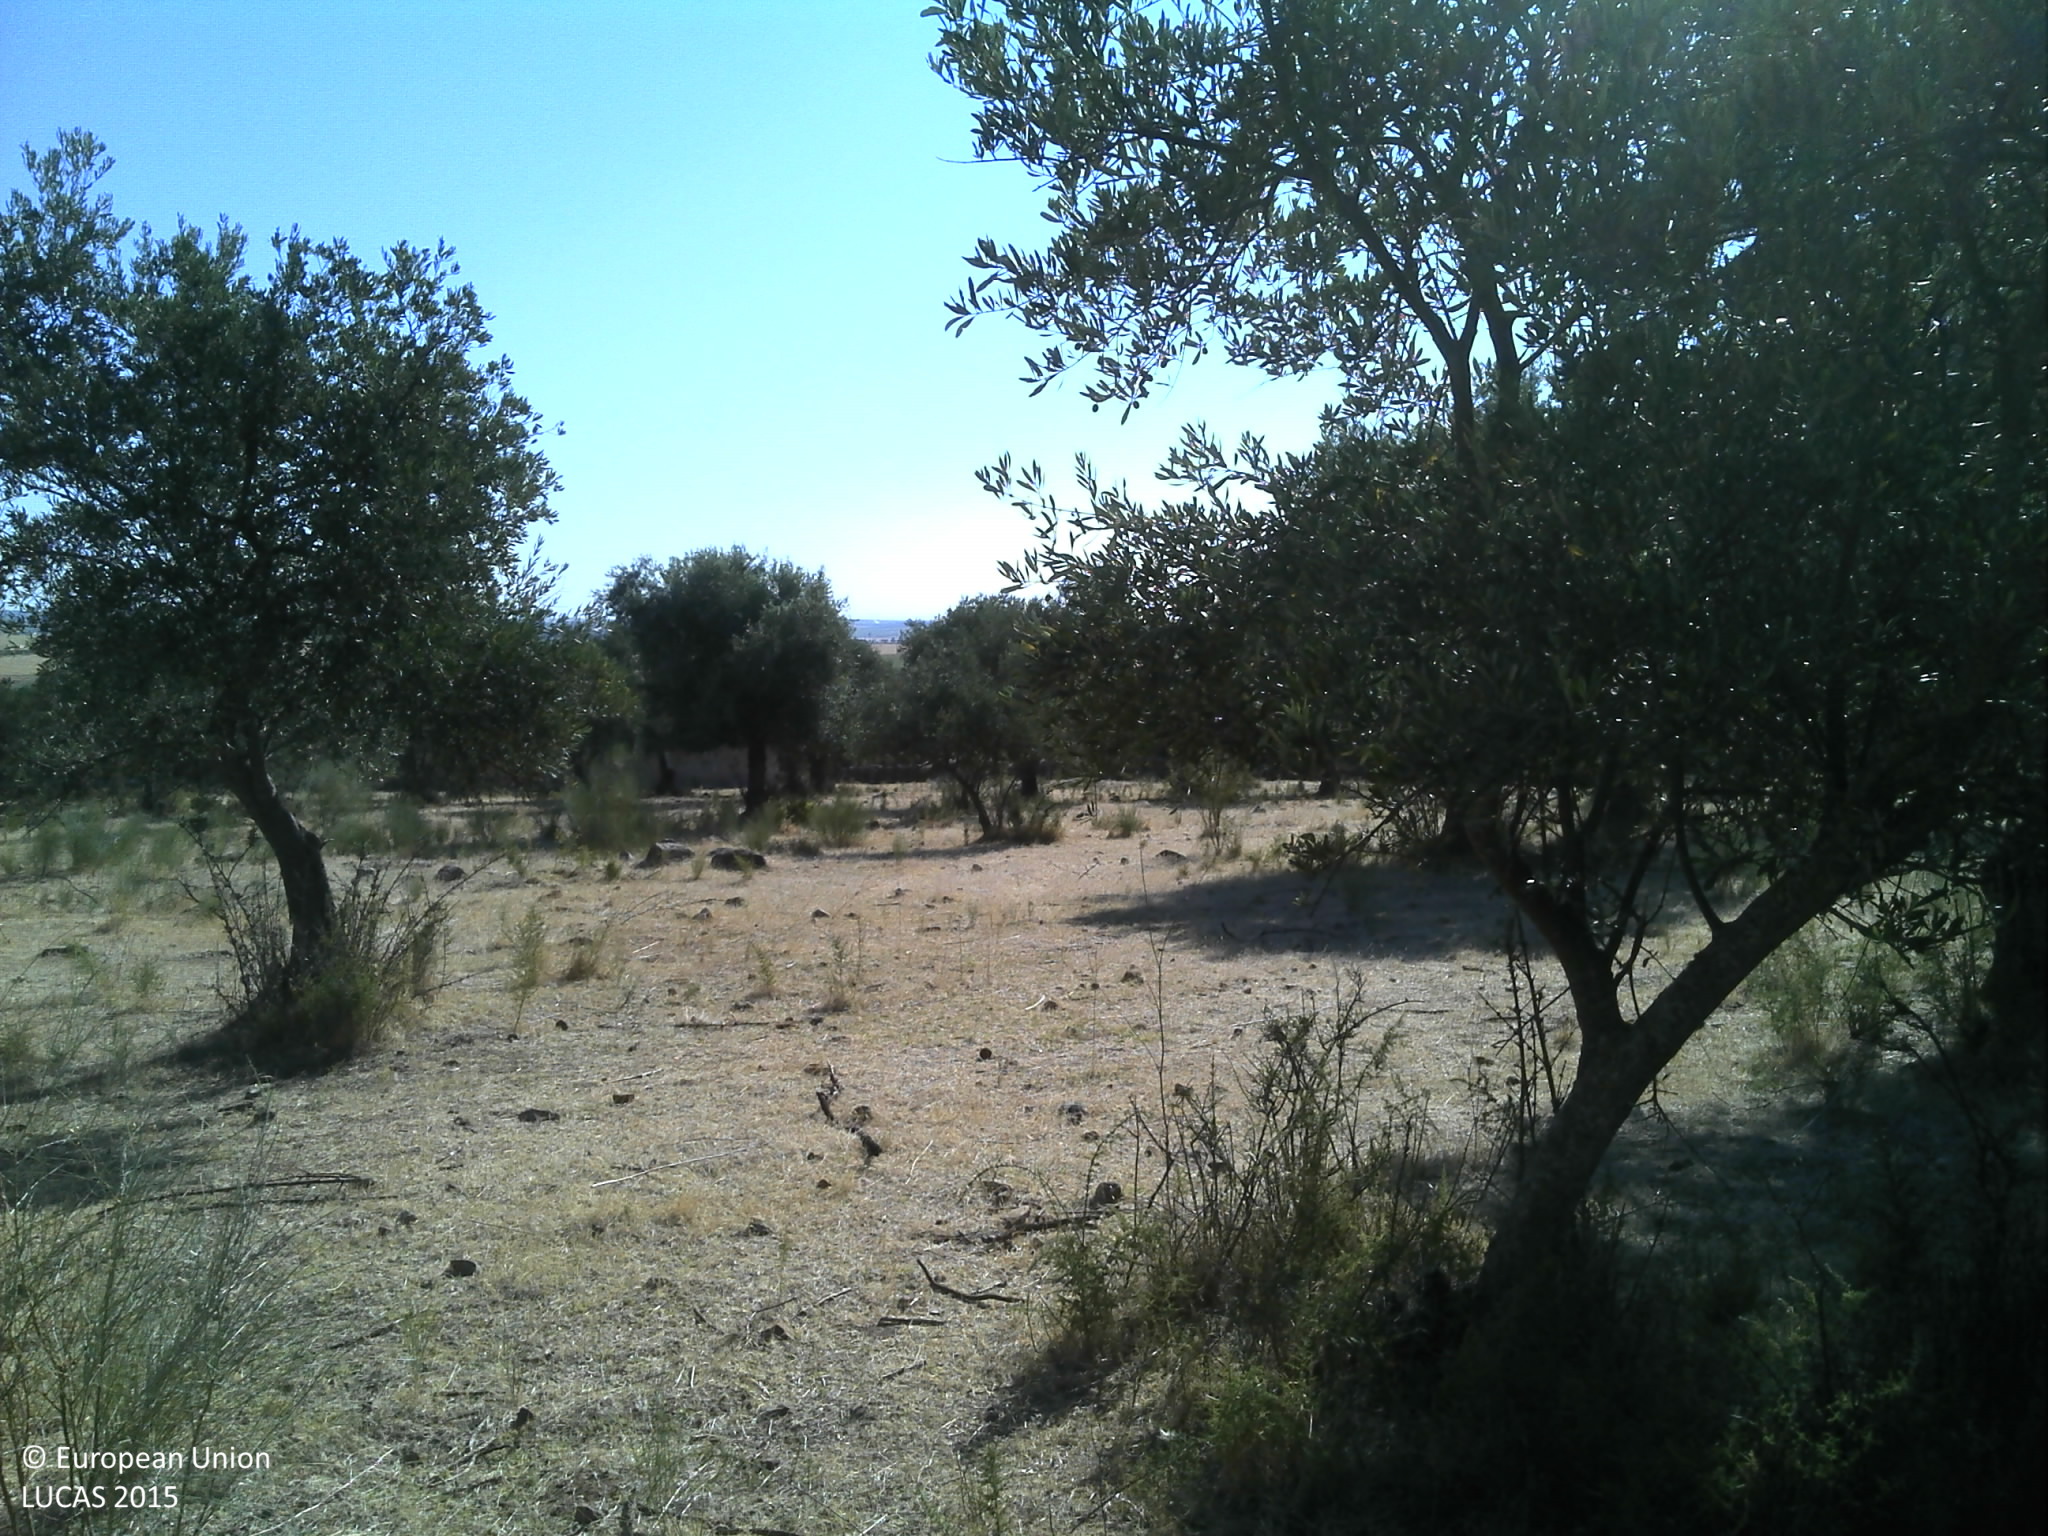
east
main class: Cropland
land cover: Olive groves
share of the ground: 25 - 50 %
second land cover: Grassland without tree/shrub cover
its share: < 10 %
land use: Agriculture (excluding fallow land and kitchen gardens)
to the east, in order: Olive groves; Grassland without tree/shrub cover; Olive groves; Broadleaved woodland; Dry stone walls; Broadleaved woodland; Tracks; Triticale
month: July
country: PT
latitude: 38.9180
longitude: -7.1084
